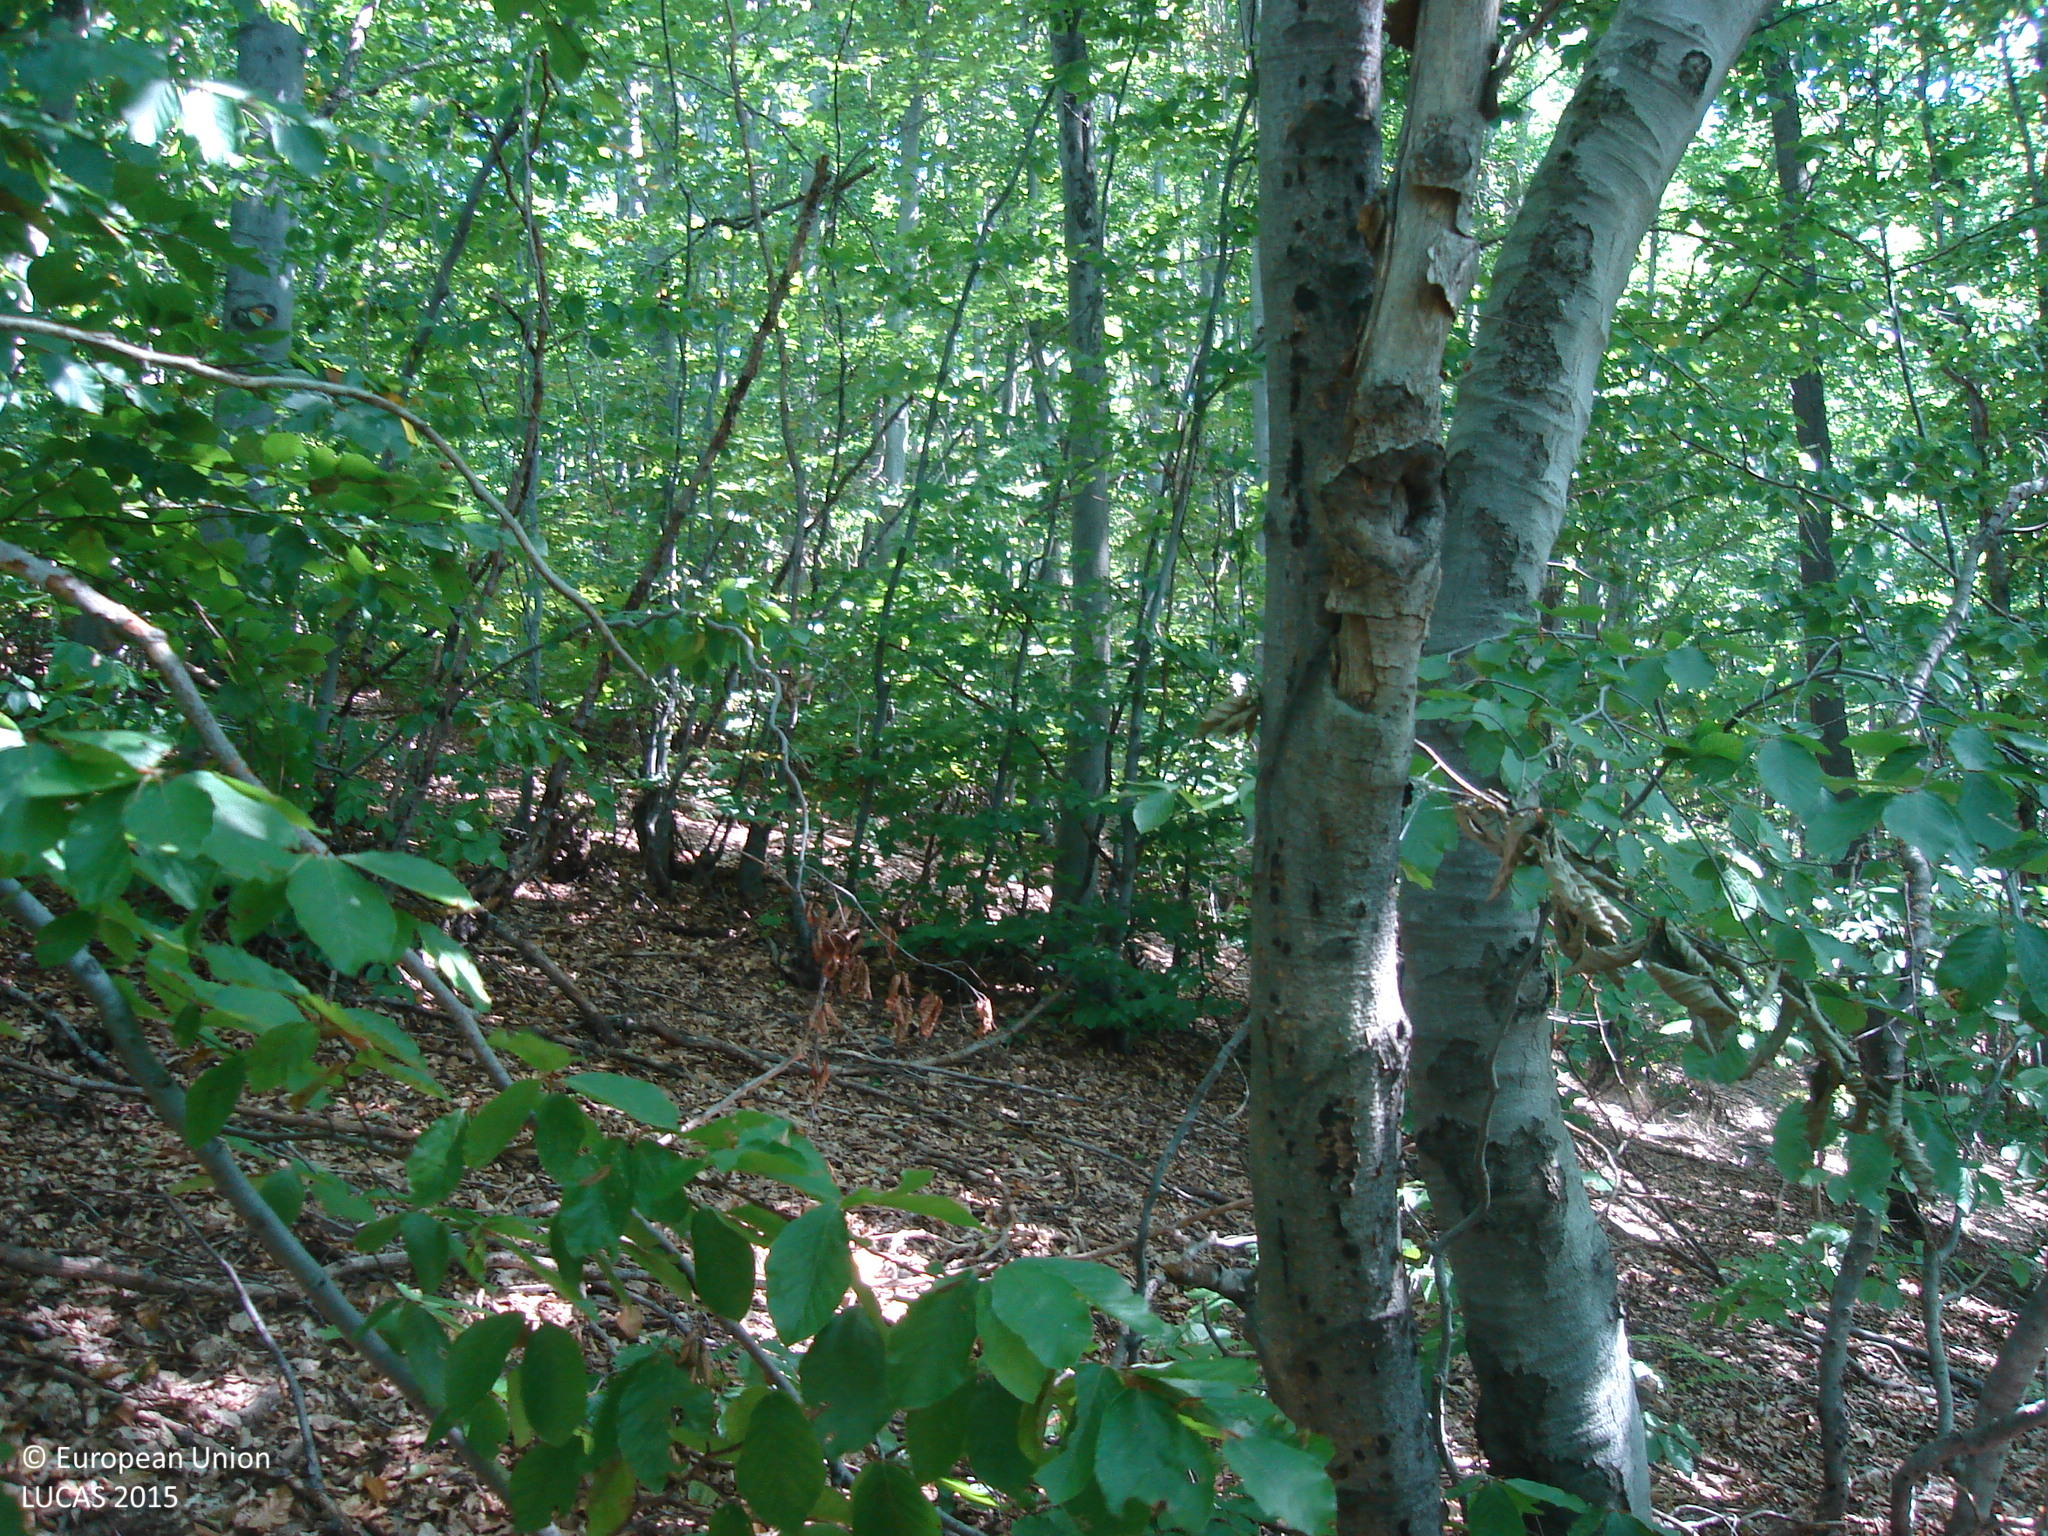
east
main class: Woodland
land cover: Broadleaved woodland
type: beech forest
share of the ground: > 75 %
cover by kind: broadleaved forest trees 100 %
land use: Forestry
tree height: > 5 m
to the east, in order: Broadleaved woodland
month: September
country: BG
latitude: 42.5264
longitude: 23.8082
